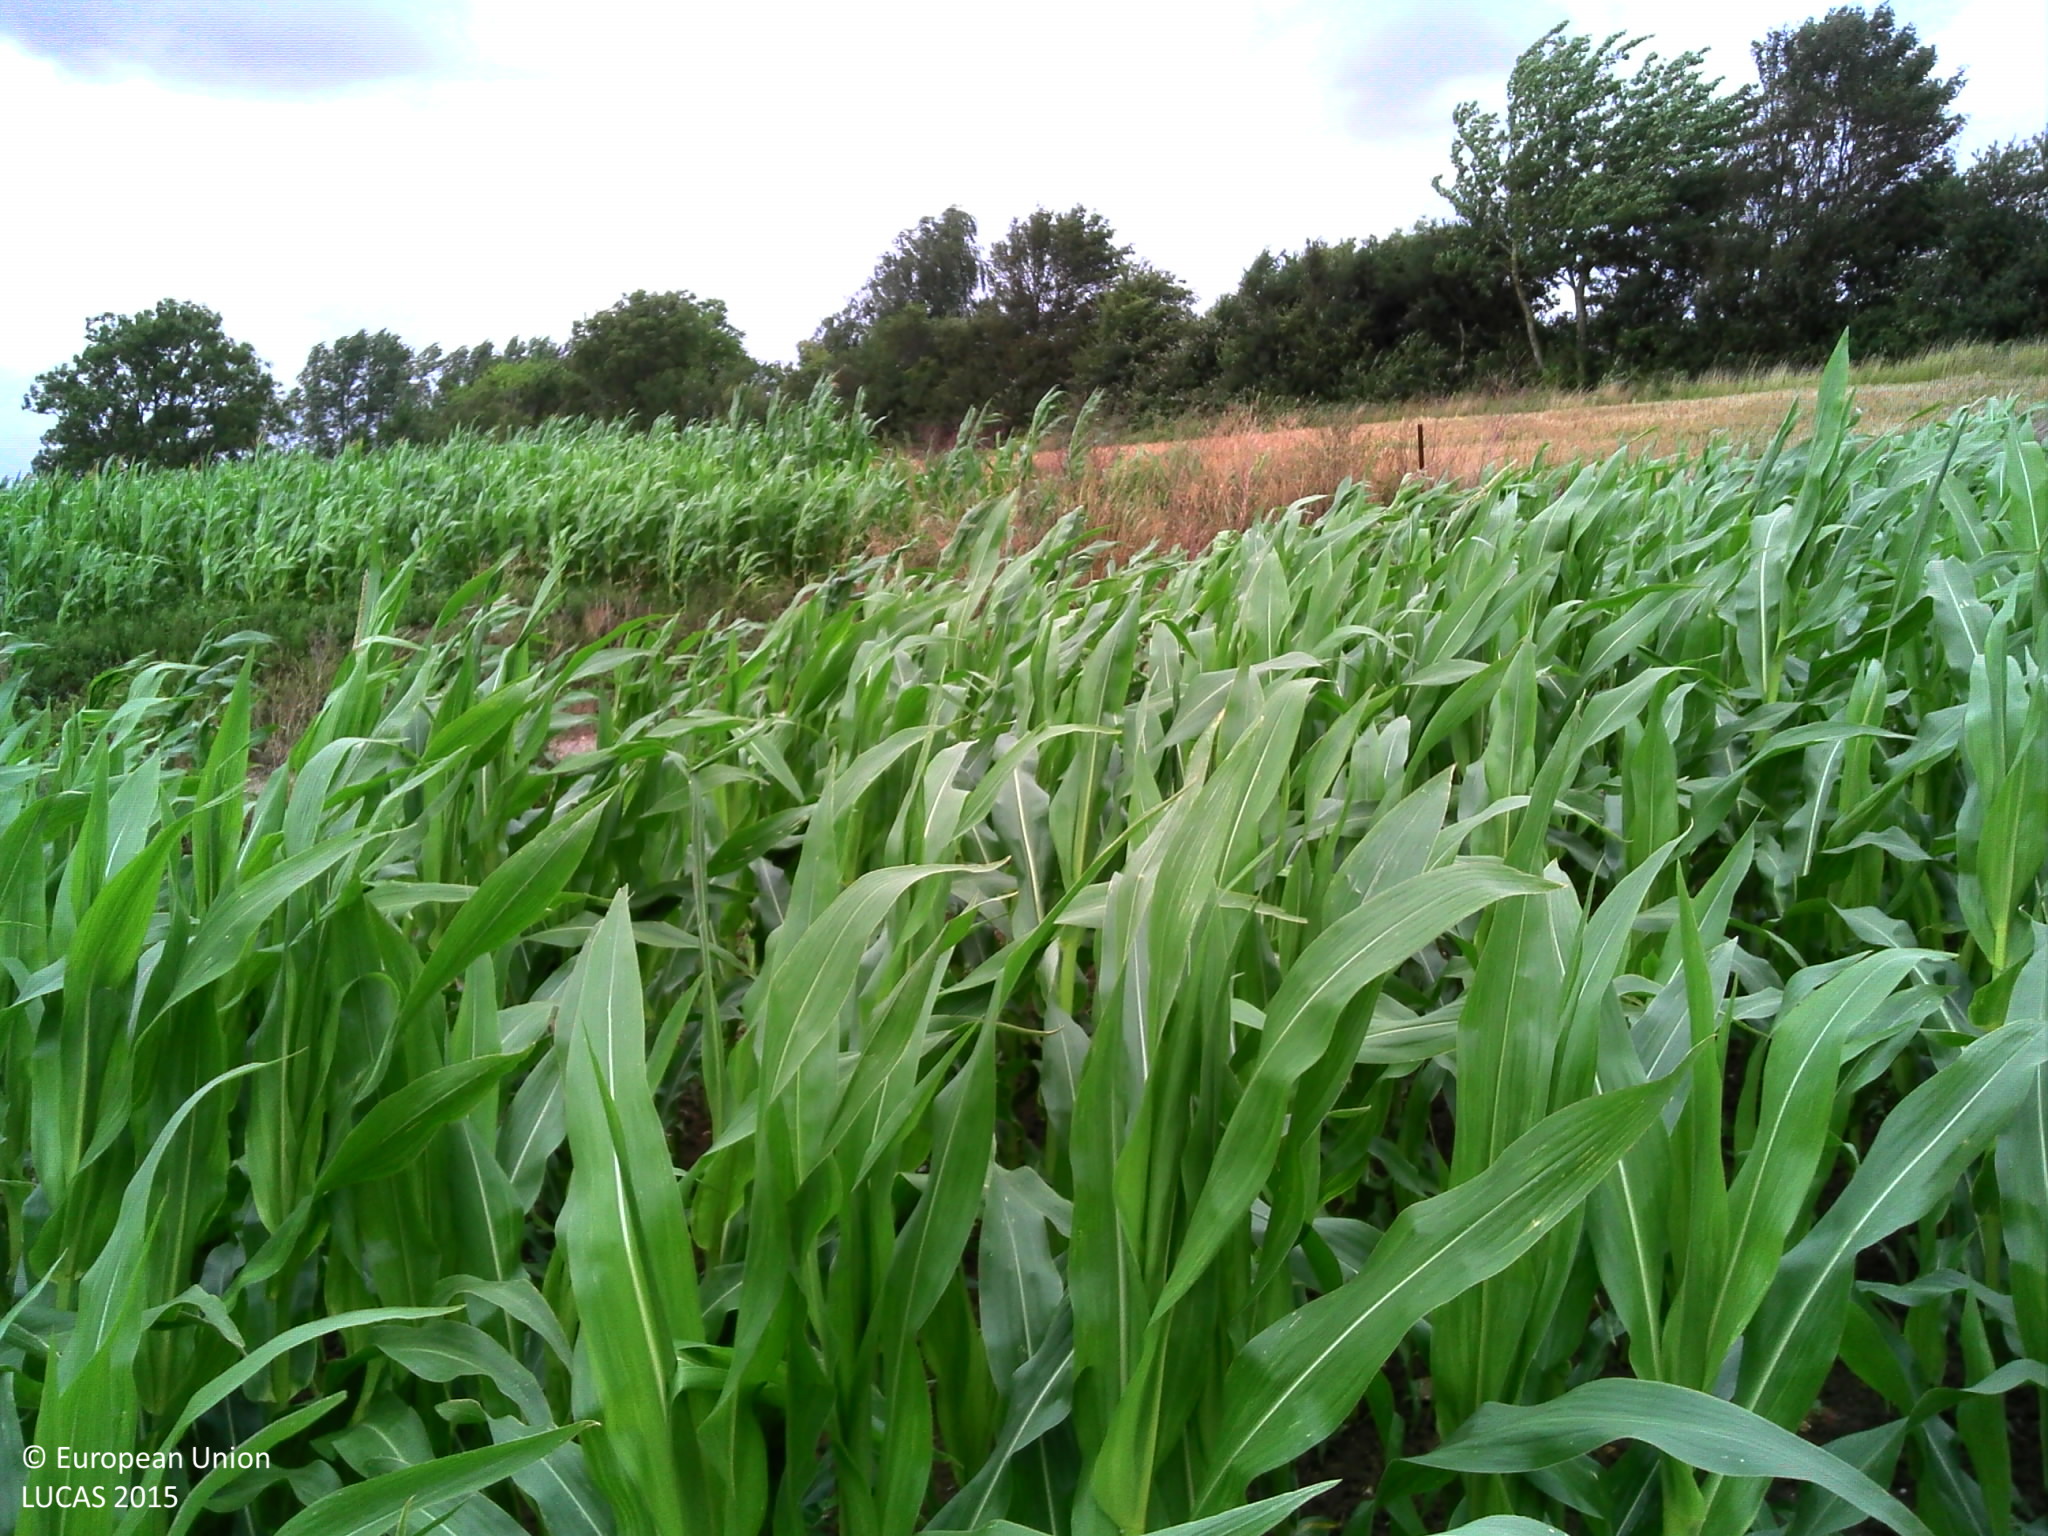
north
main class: Cropland
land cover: Maize
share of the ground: > 75 %
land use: Agriculture (excluding fallow land and kitchen gardens)
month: July
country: FR
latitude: 50.7435
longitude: 2.4049
